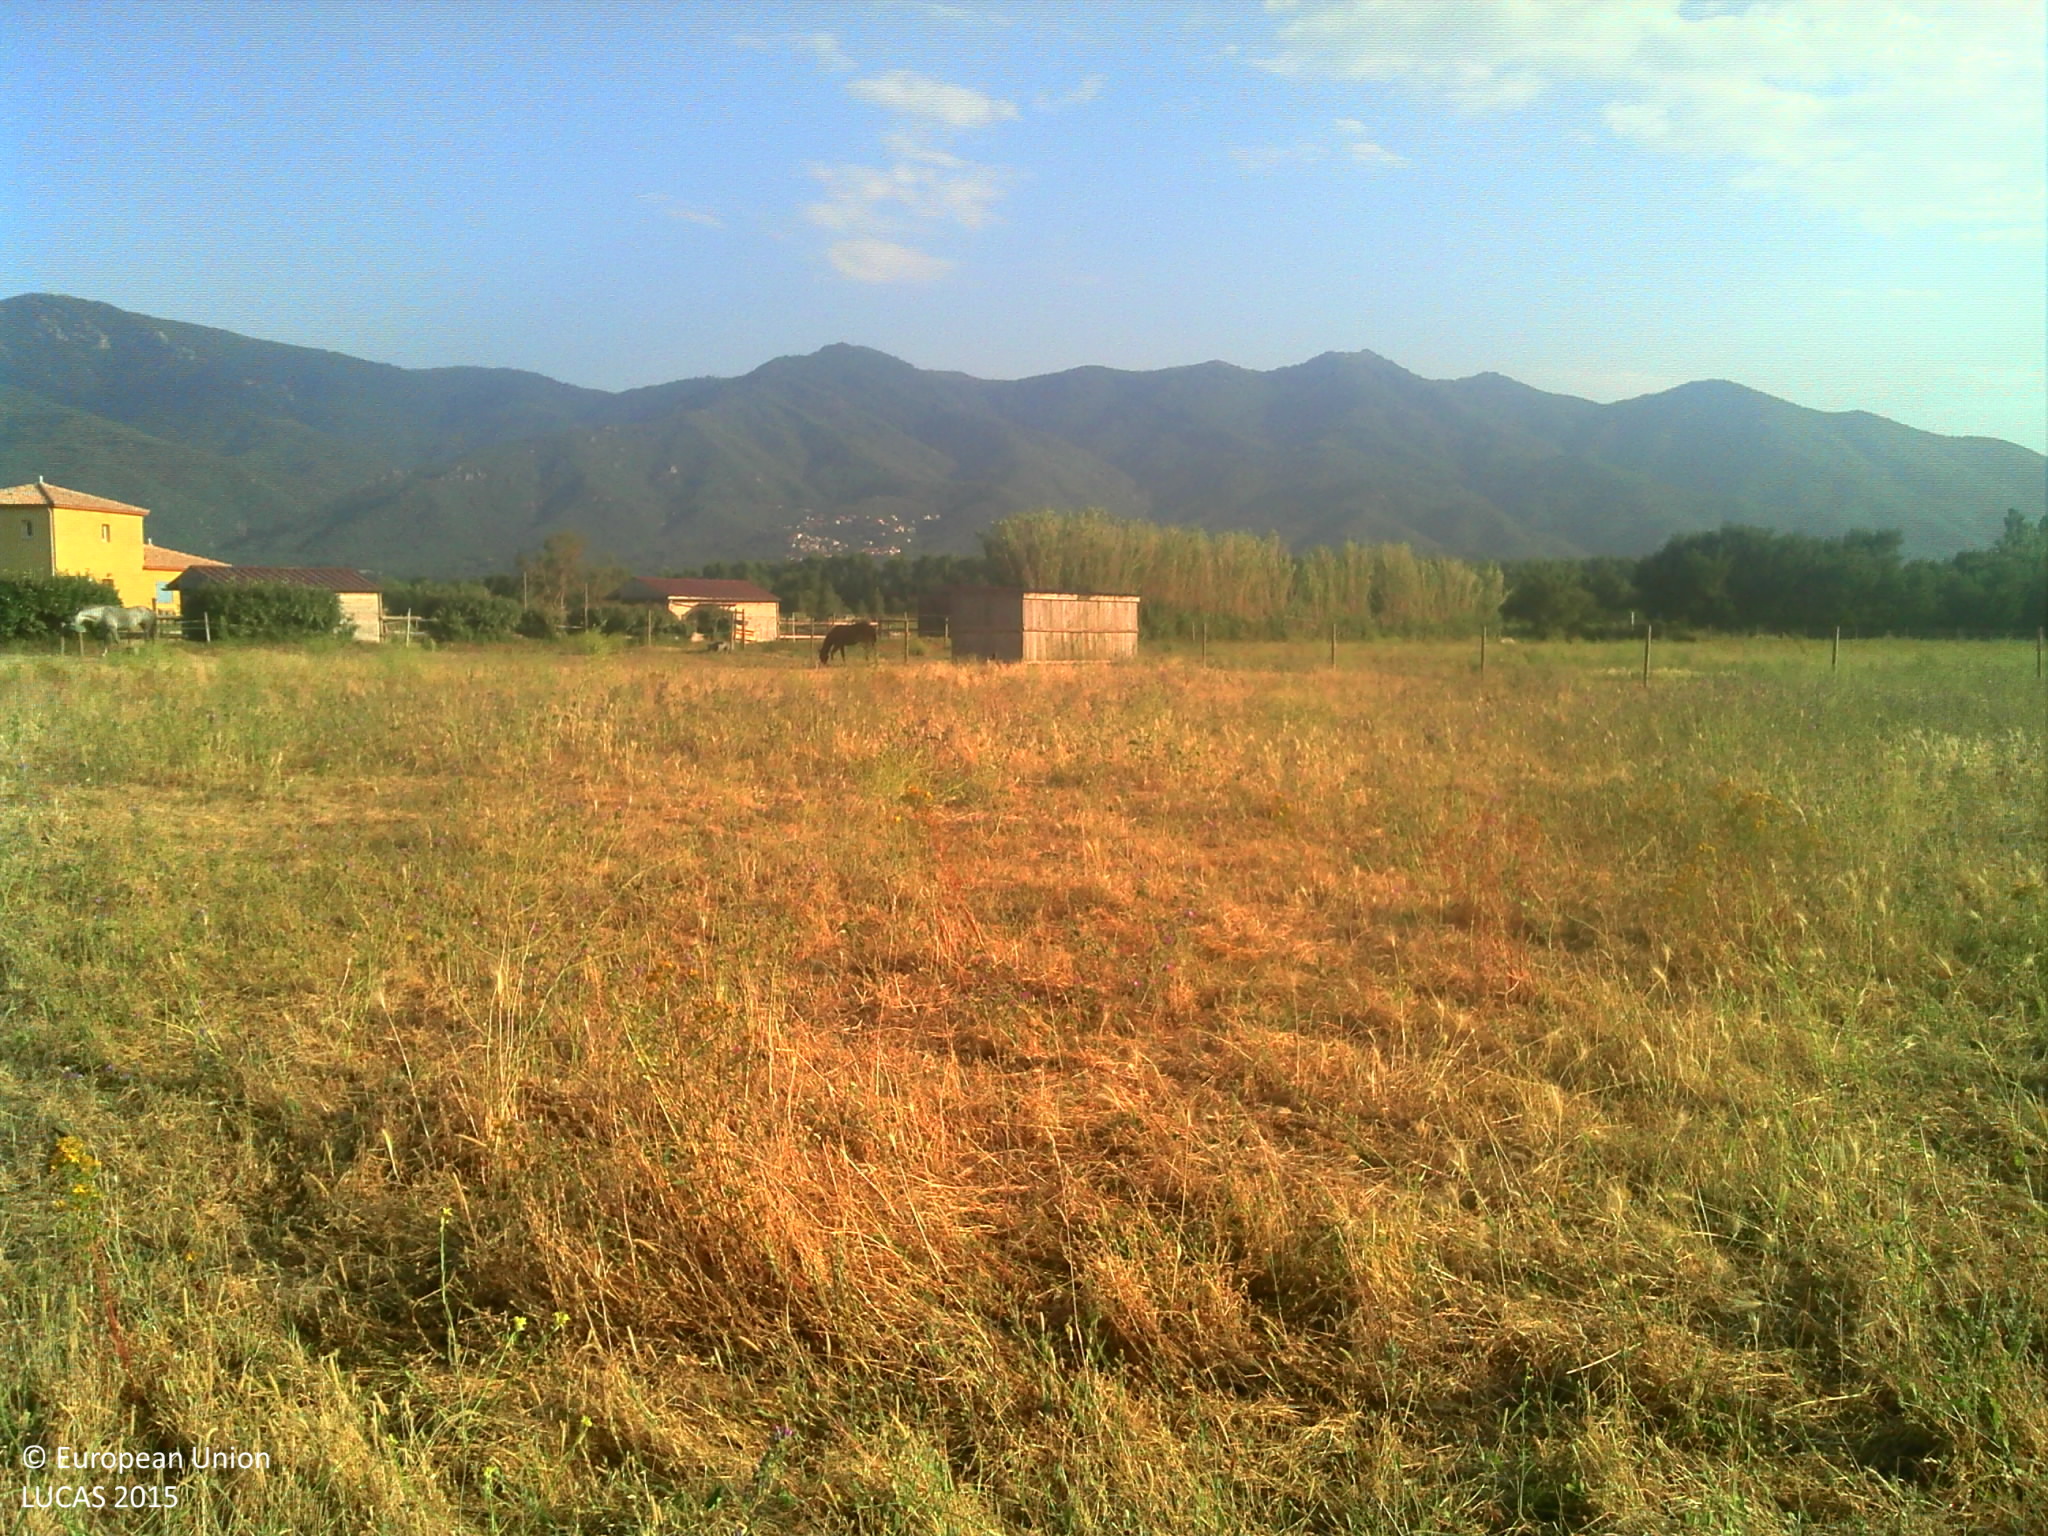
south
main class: Grassland
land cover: Grassland without tree/shrub cover
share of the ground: > 75 %
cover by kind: herbaceous plants 100 %
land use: Agriculture (excluding fallow land and kitchen gardens)
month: June
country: FR
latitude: 42.5506
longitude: 2.9127
